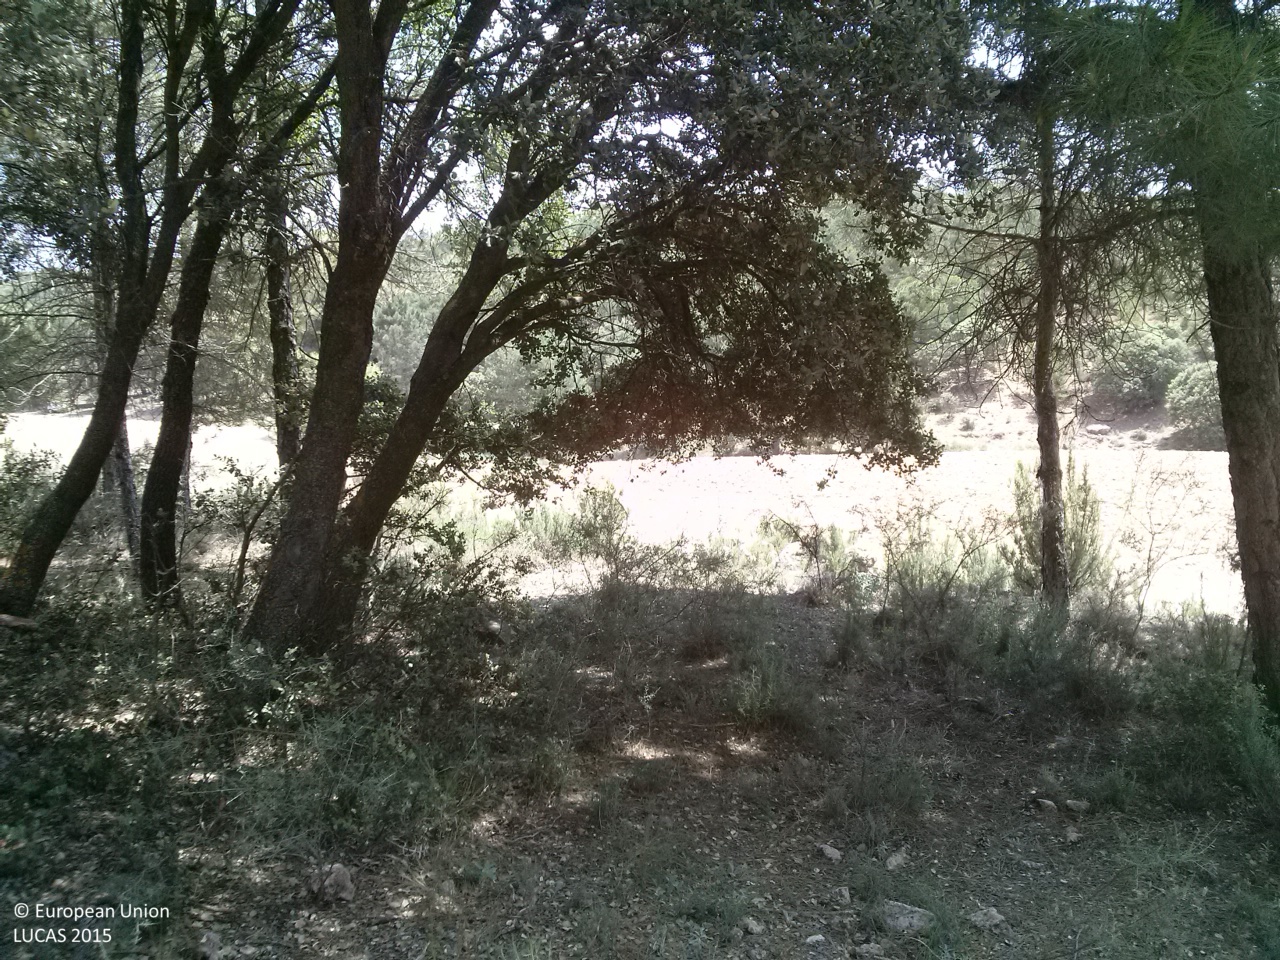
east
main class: Woodland
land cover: Other mixed woodland
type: broadleaved evergreen forest
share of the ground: 25 - 50 %
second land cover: Shrubland without tree cover
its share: 25 - 50 %
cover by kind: shrubs 30 %, coniferous forest trees 25 %, herbaceous plants 20 %, broadleaved forest trees 15 %, unconsolidated bare surface 10 %
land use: Forestry
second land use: Agriculture (excluding fallow land and kitchen gardens)
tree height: > 5 m
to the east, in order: Other mixed woodland; Shrubland without tree cover; Sunflower; Grass margins; Sunflower; Grass margins; Tracks; Pine dominated mixed woodland
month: June
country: ES
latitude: 39.8803
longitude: -1.8089
